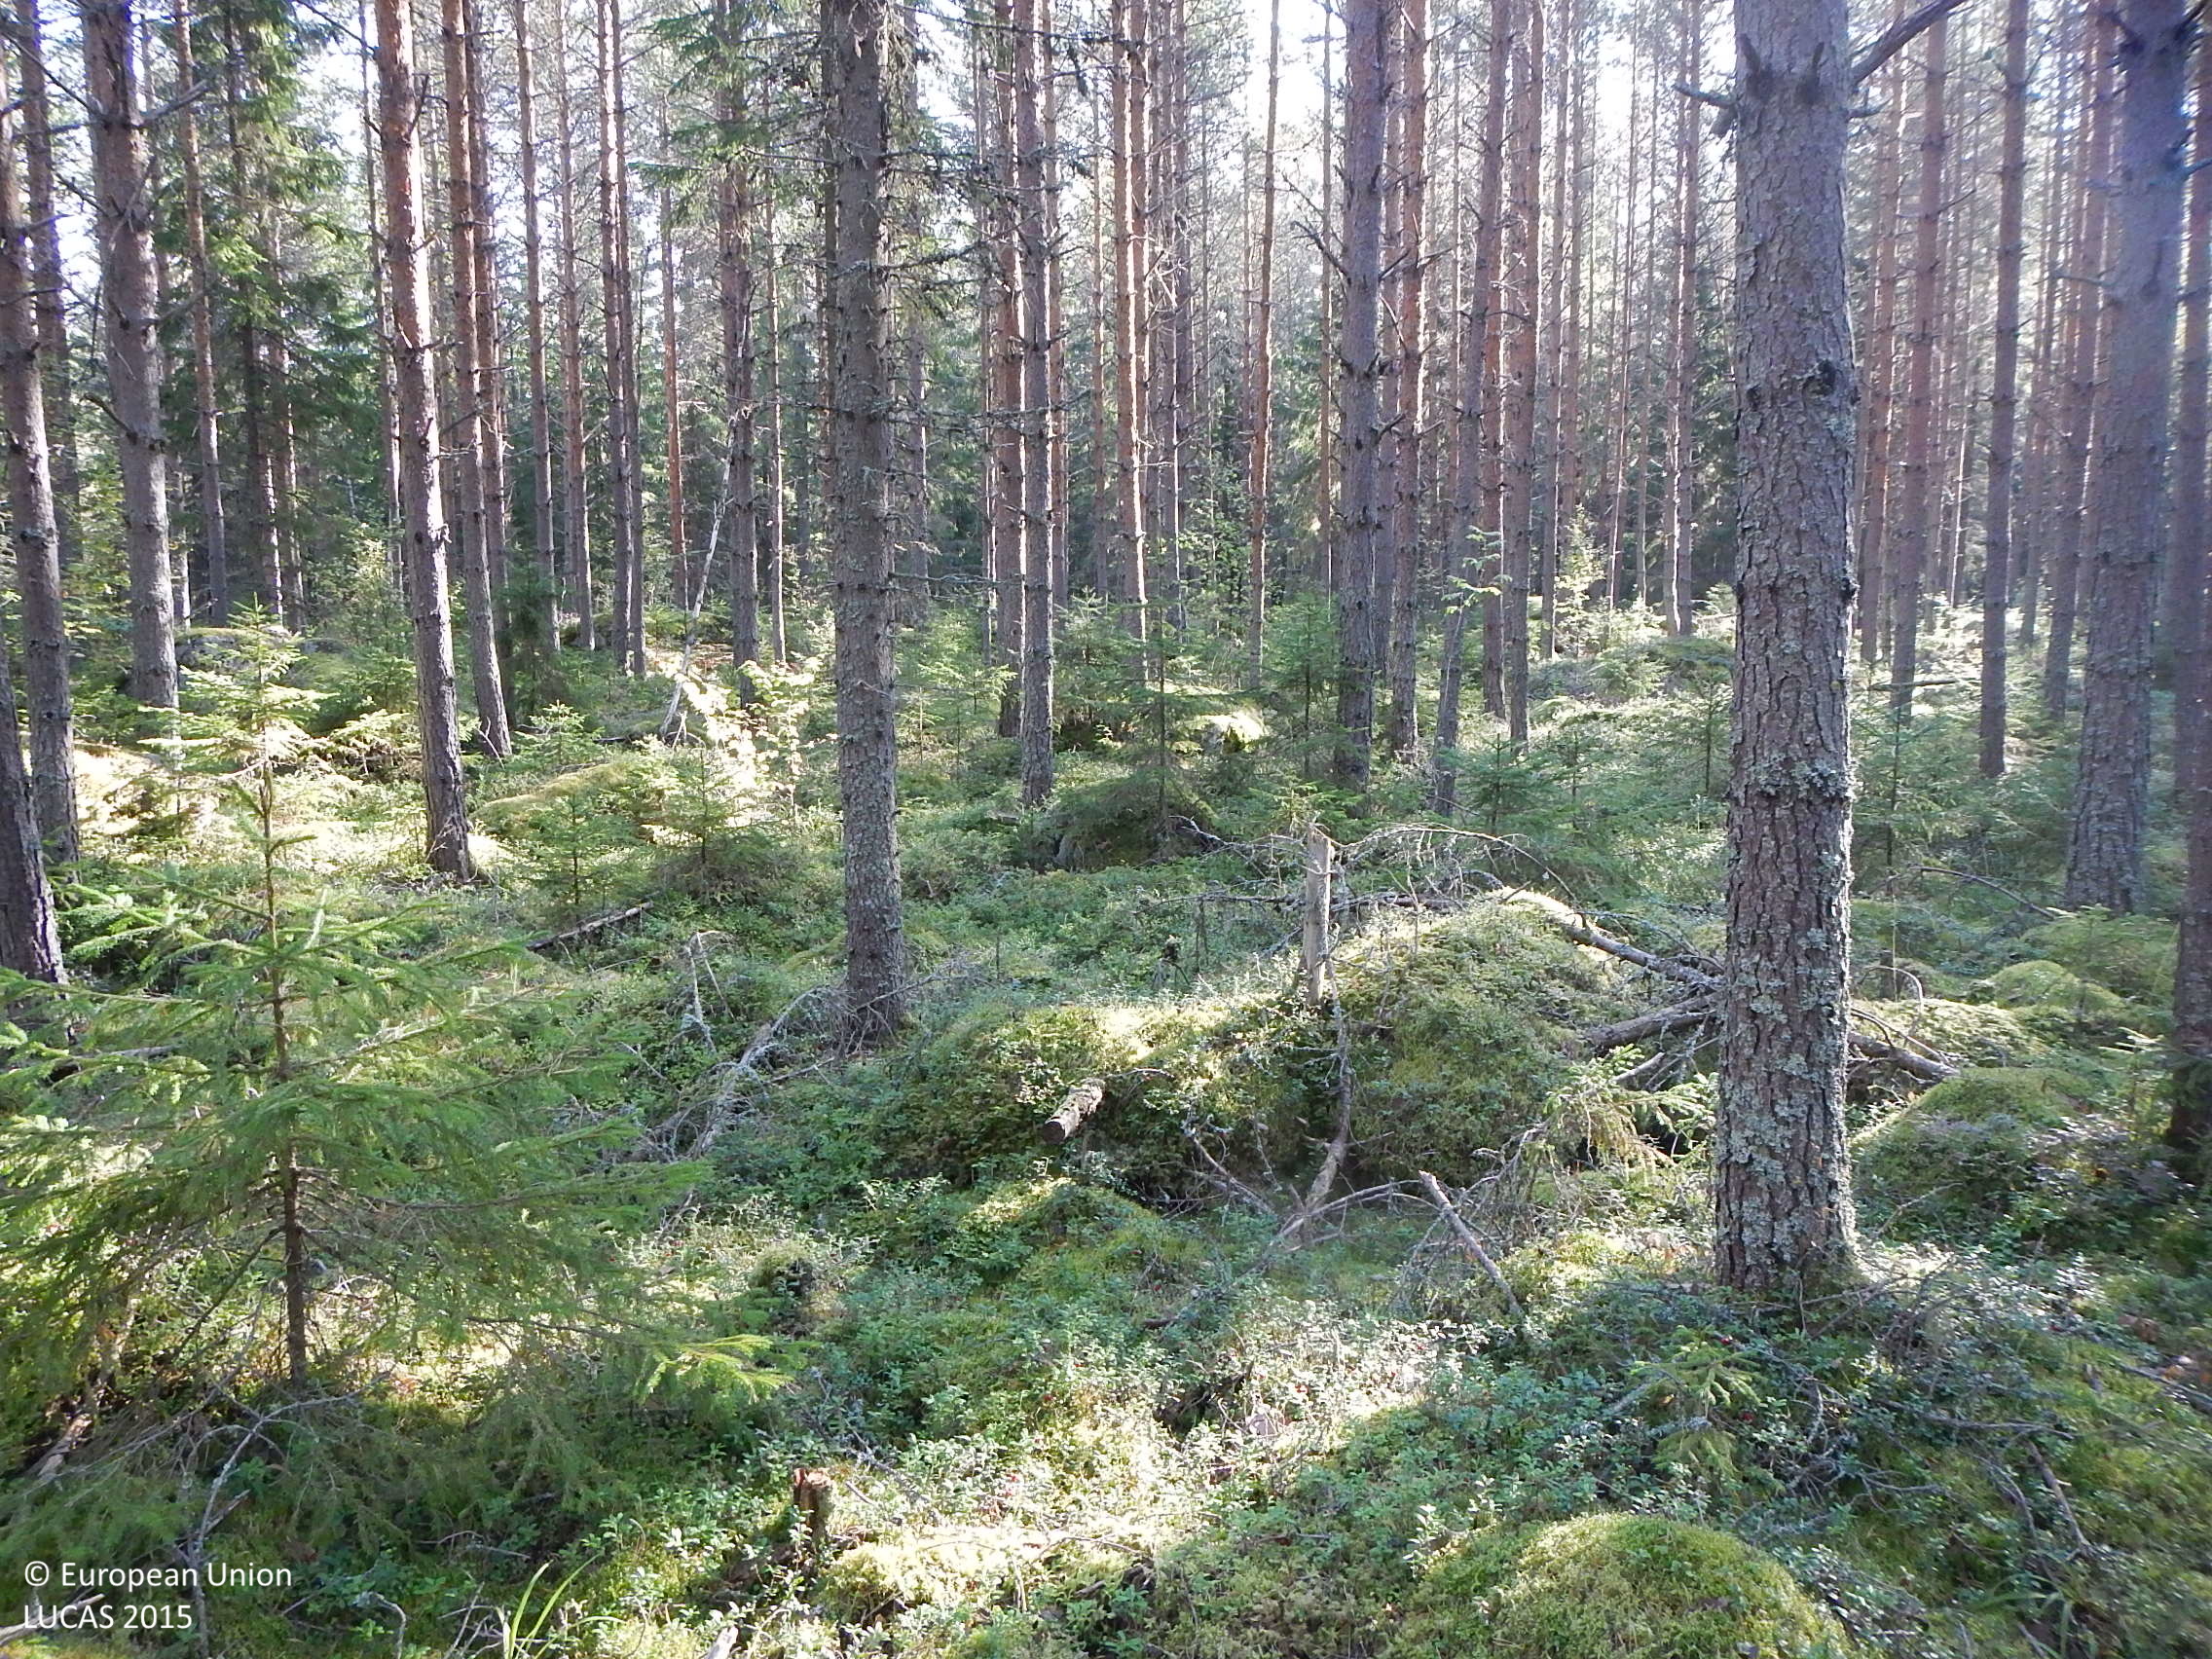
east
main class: Woodland
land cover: Pine dominated coniferous woodland
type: boreal forest
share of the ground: > 75 %
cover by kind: coniferous forest trees 75 %, lichens and mosses 25 %
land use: Forestry
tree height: > 5 m
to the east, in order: Pine dominated coniferous woodland; Spruce dominated mixed woodland; Ditches and canals; Spruce dominated mixed woodland; Shrubland without tree cover
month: September
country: FI
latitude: 61.6250
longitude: 22.1485
